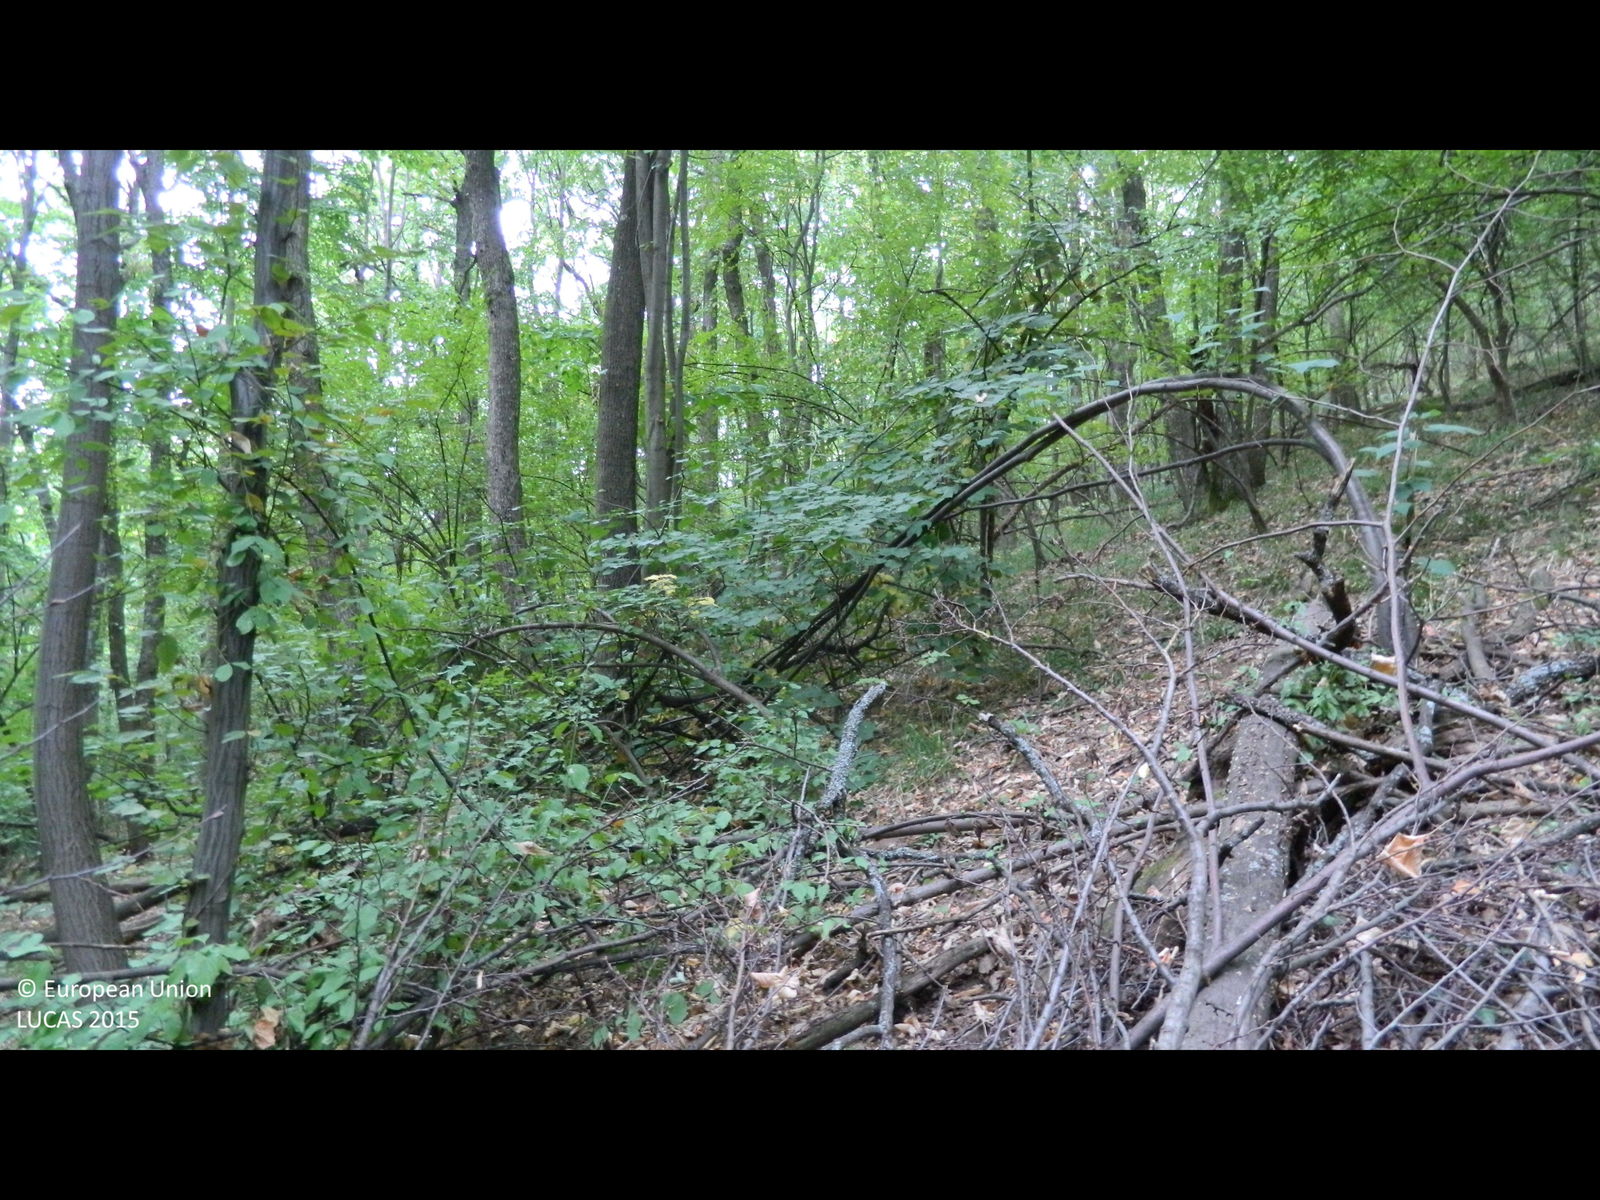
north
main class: Woodland
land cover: Broadleaved woodland
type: mesophytic deciduous forest
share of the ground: > 75 %
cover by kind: broadleaved forest trees 100 %
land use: Forestry
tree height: > 5 m
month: August
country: BG
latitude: 41.7309
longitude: 25.8284
